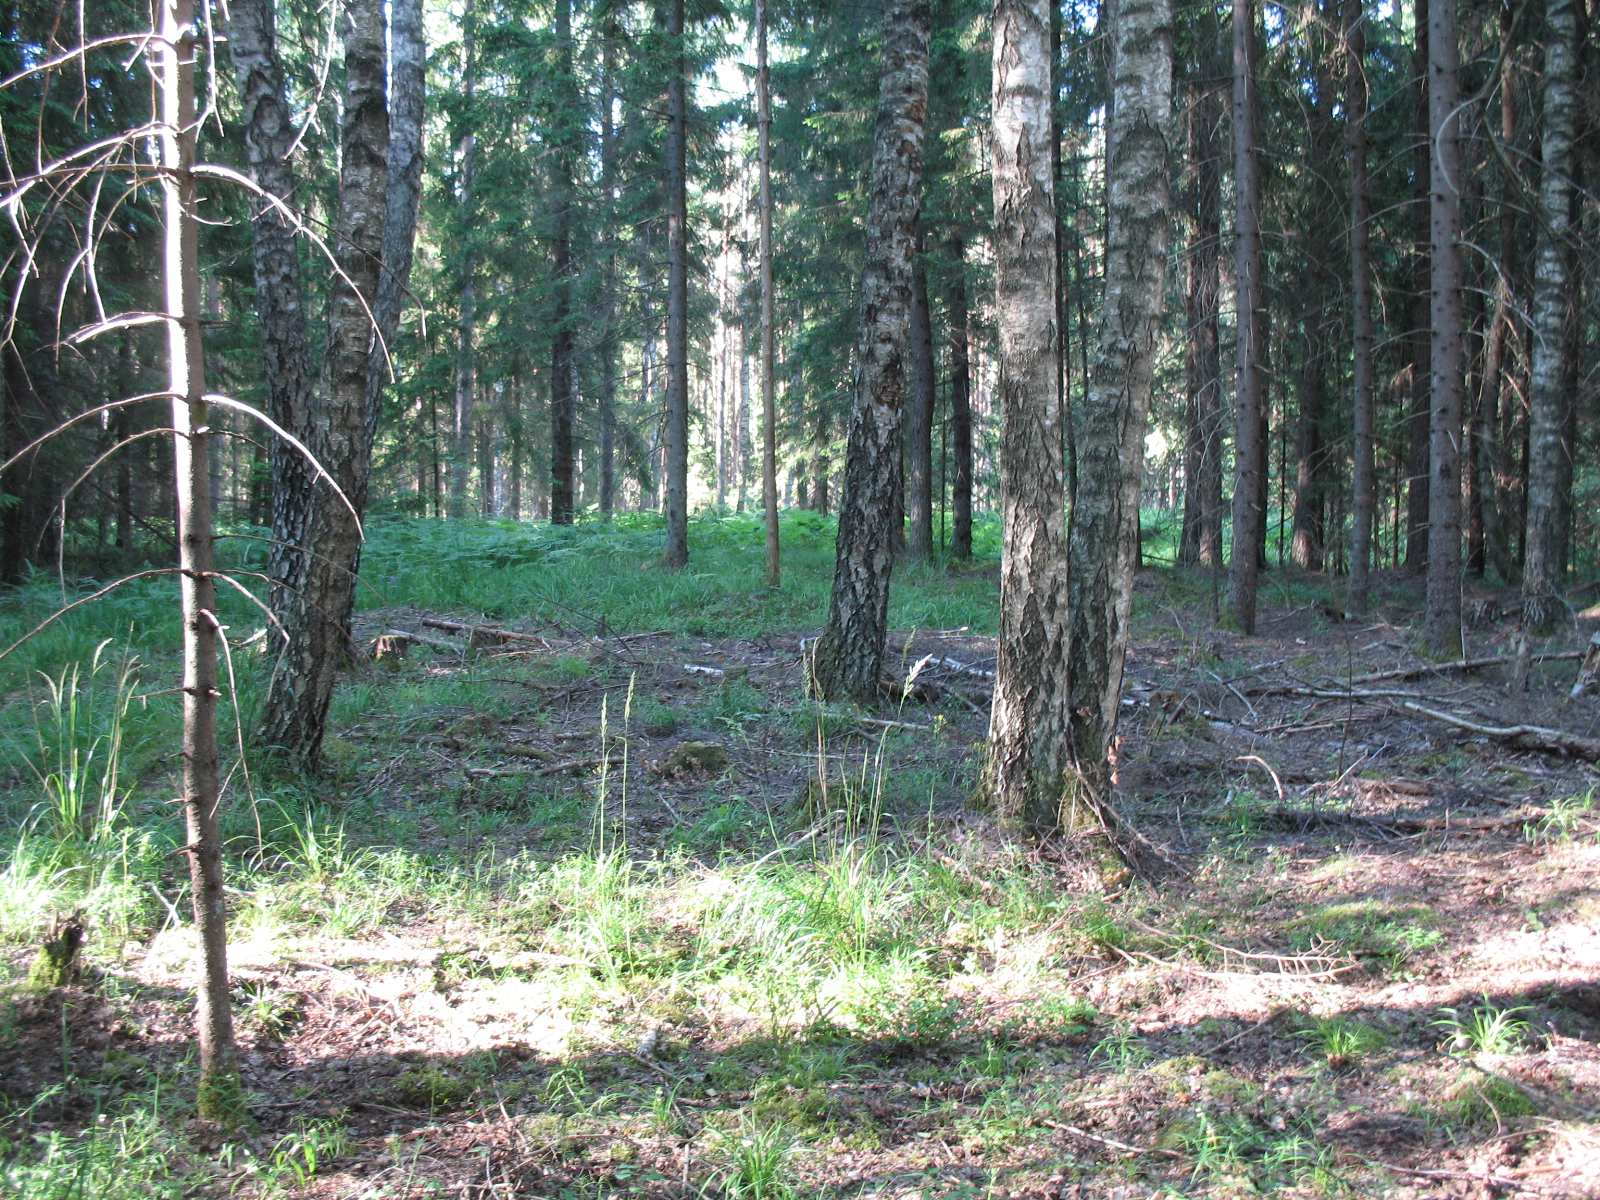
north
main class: Woodland
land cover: Spruce dominated mixed woodland
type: hemiboreal forest and nemoral coniferous forest and mixed broadleaved-coniferous forest
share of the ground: > 75 %
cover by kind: coniferous forest trees 45 %, broadleaved forest trees 45 %, herbaceous plants 5 %, lichens and mosses 5 %
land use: Forestry
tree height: > 5 m
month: July
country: LV
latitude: 56.7706
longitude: 23.8077
